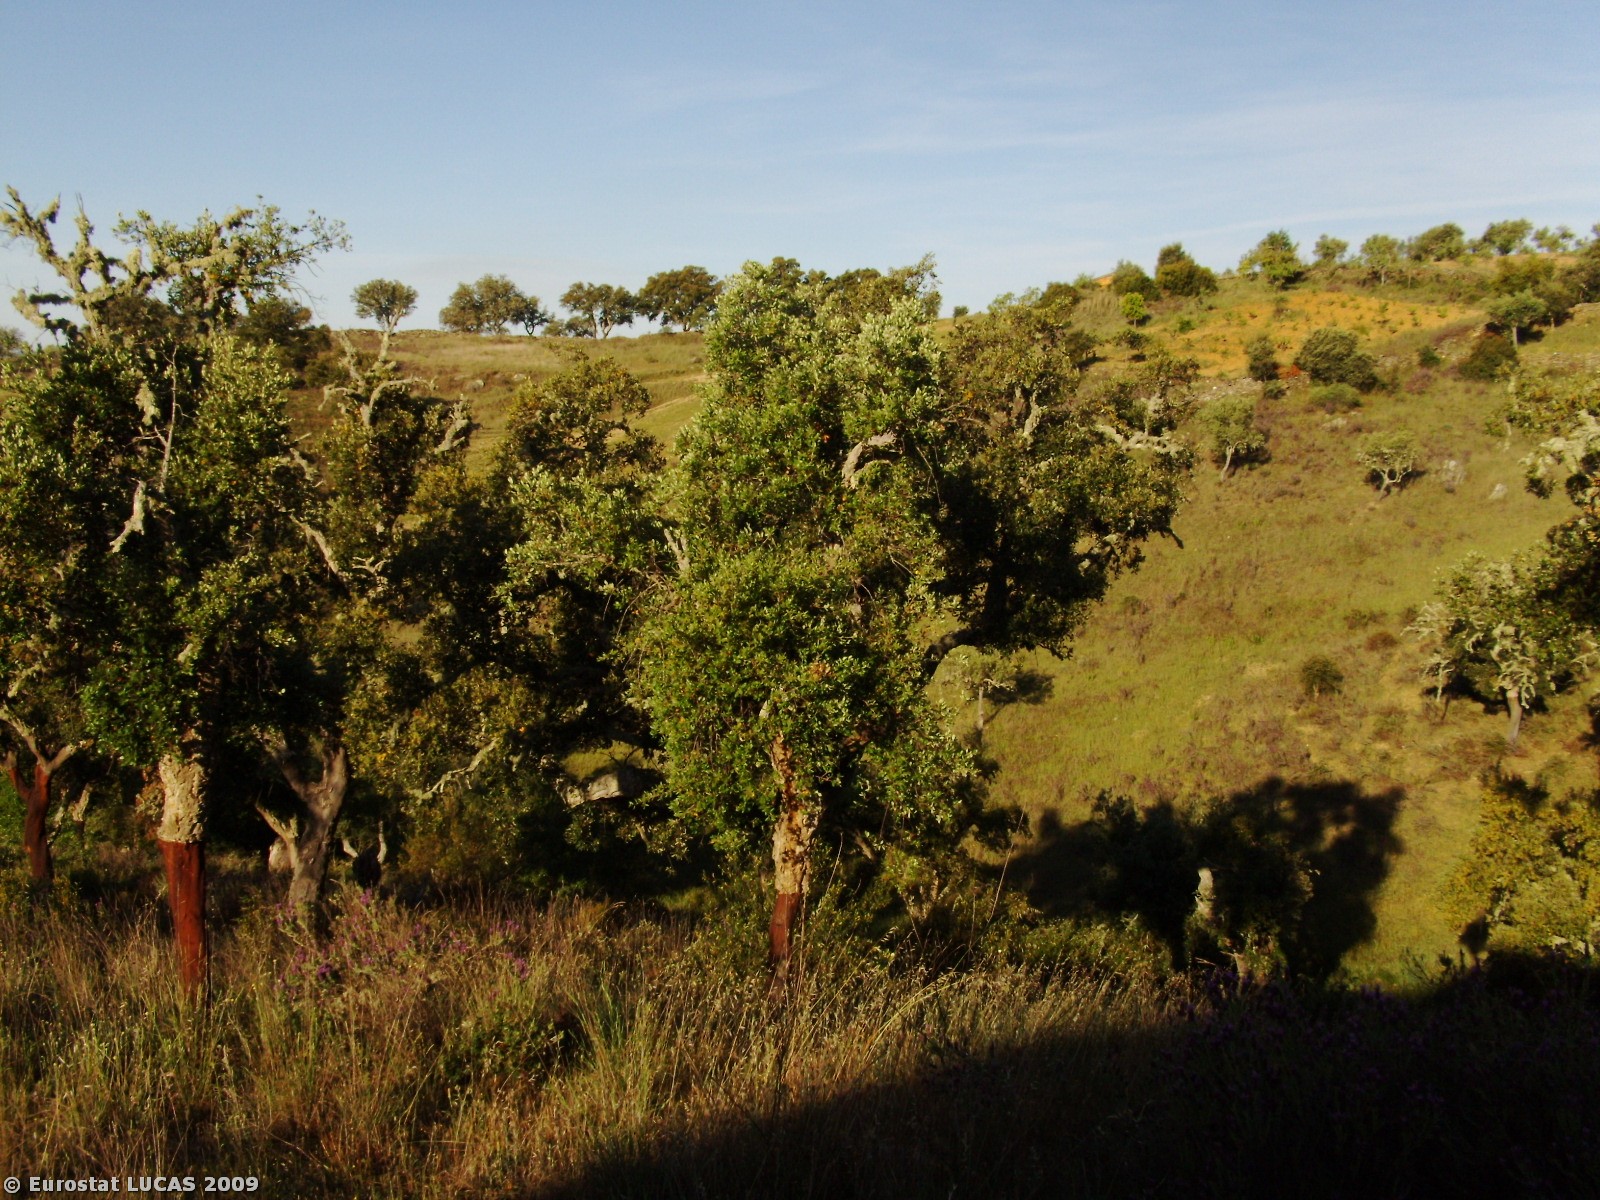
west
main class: Woodland
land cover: Broadleaved woodland
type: broadleaved evergreen forest
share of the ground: 25 - 50 %
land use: Forestry
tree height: > 5 m
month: May
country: PT
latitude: 39.6645
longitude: -7.5711
